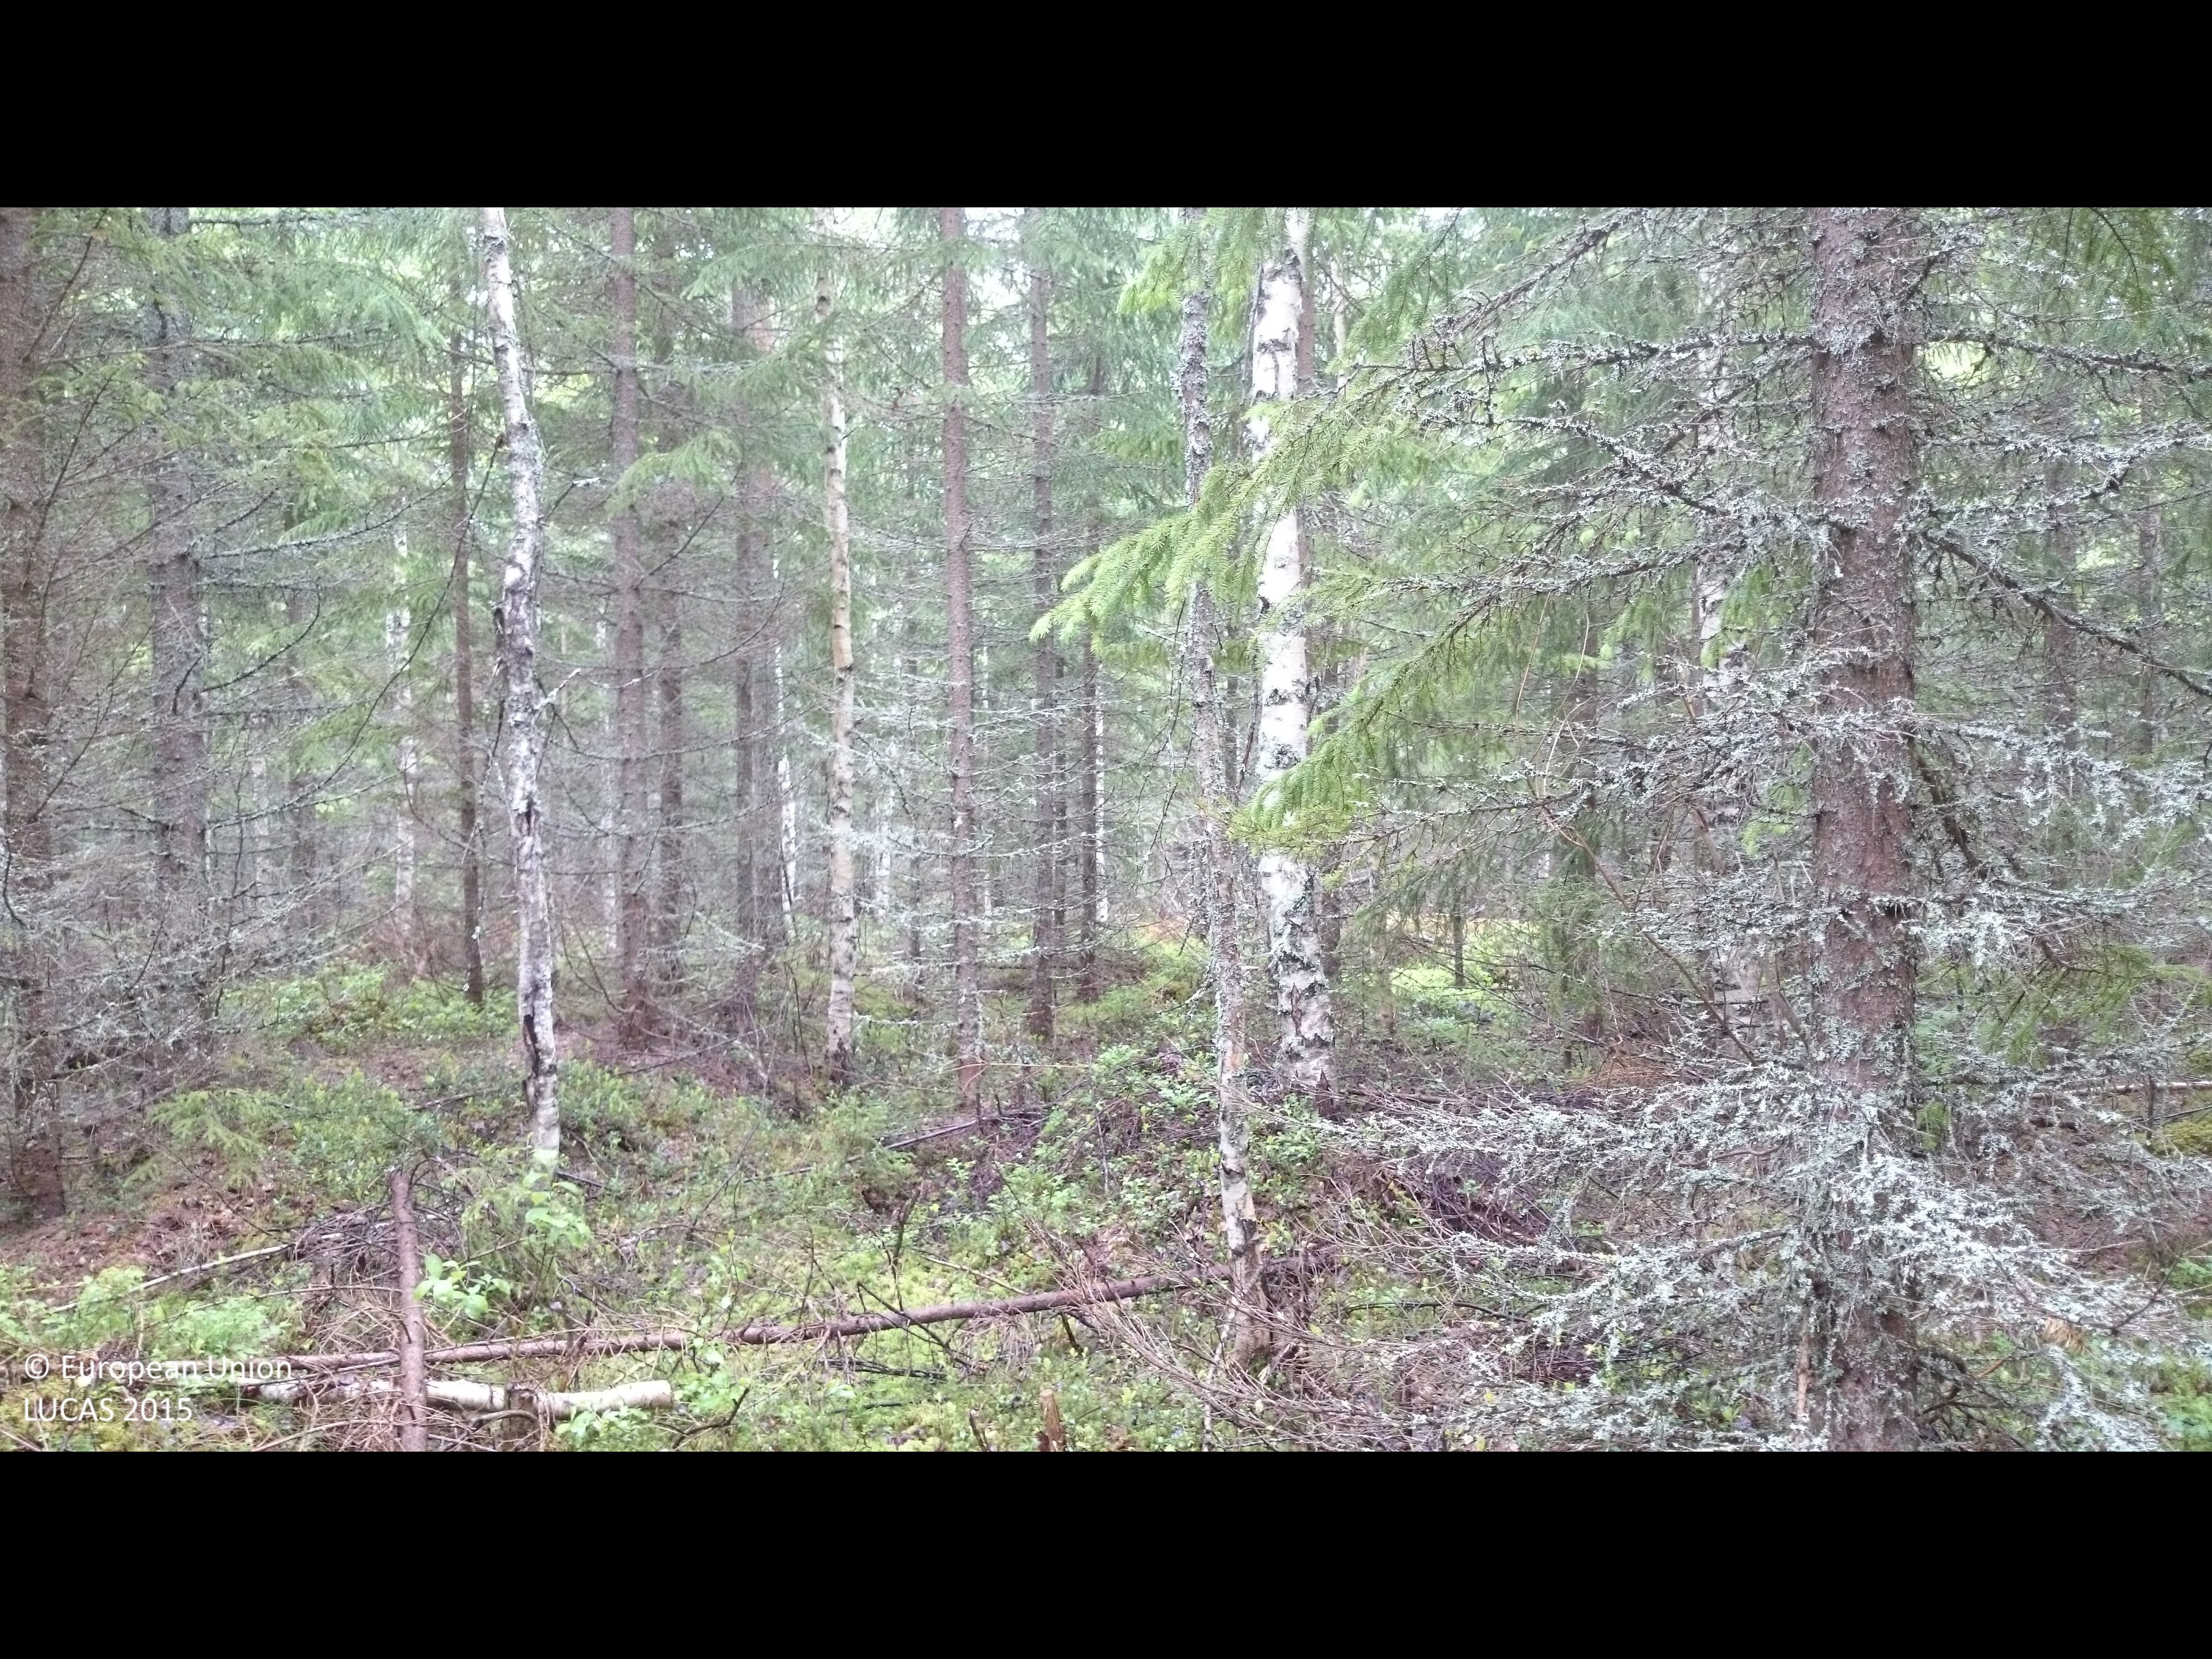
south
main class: Woodland
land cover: Spruce dominated mixed woodland
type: boreal forest
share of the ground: 25 - 50 %
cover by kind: lichens and mosses 35 %, coniferous forest trees 30 %, shrubs 20 %, broadleaved forest trees 15 %
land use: Forestry
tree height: > 5 m
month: June
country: SE
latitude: 61.9883
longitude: 16.7959
